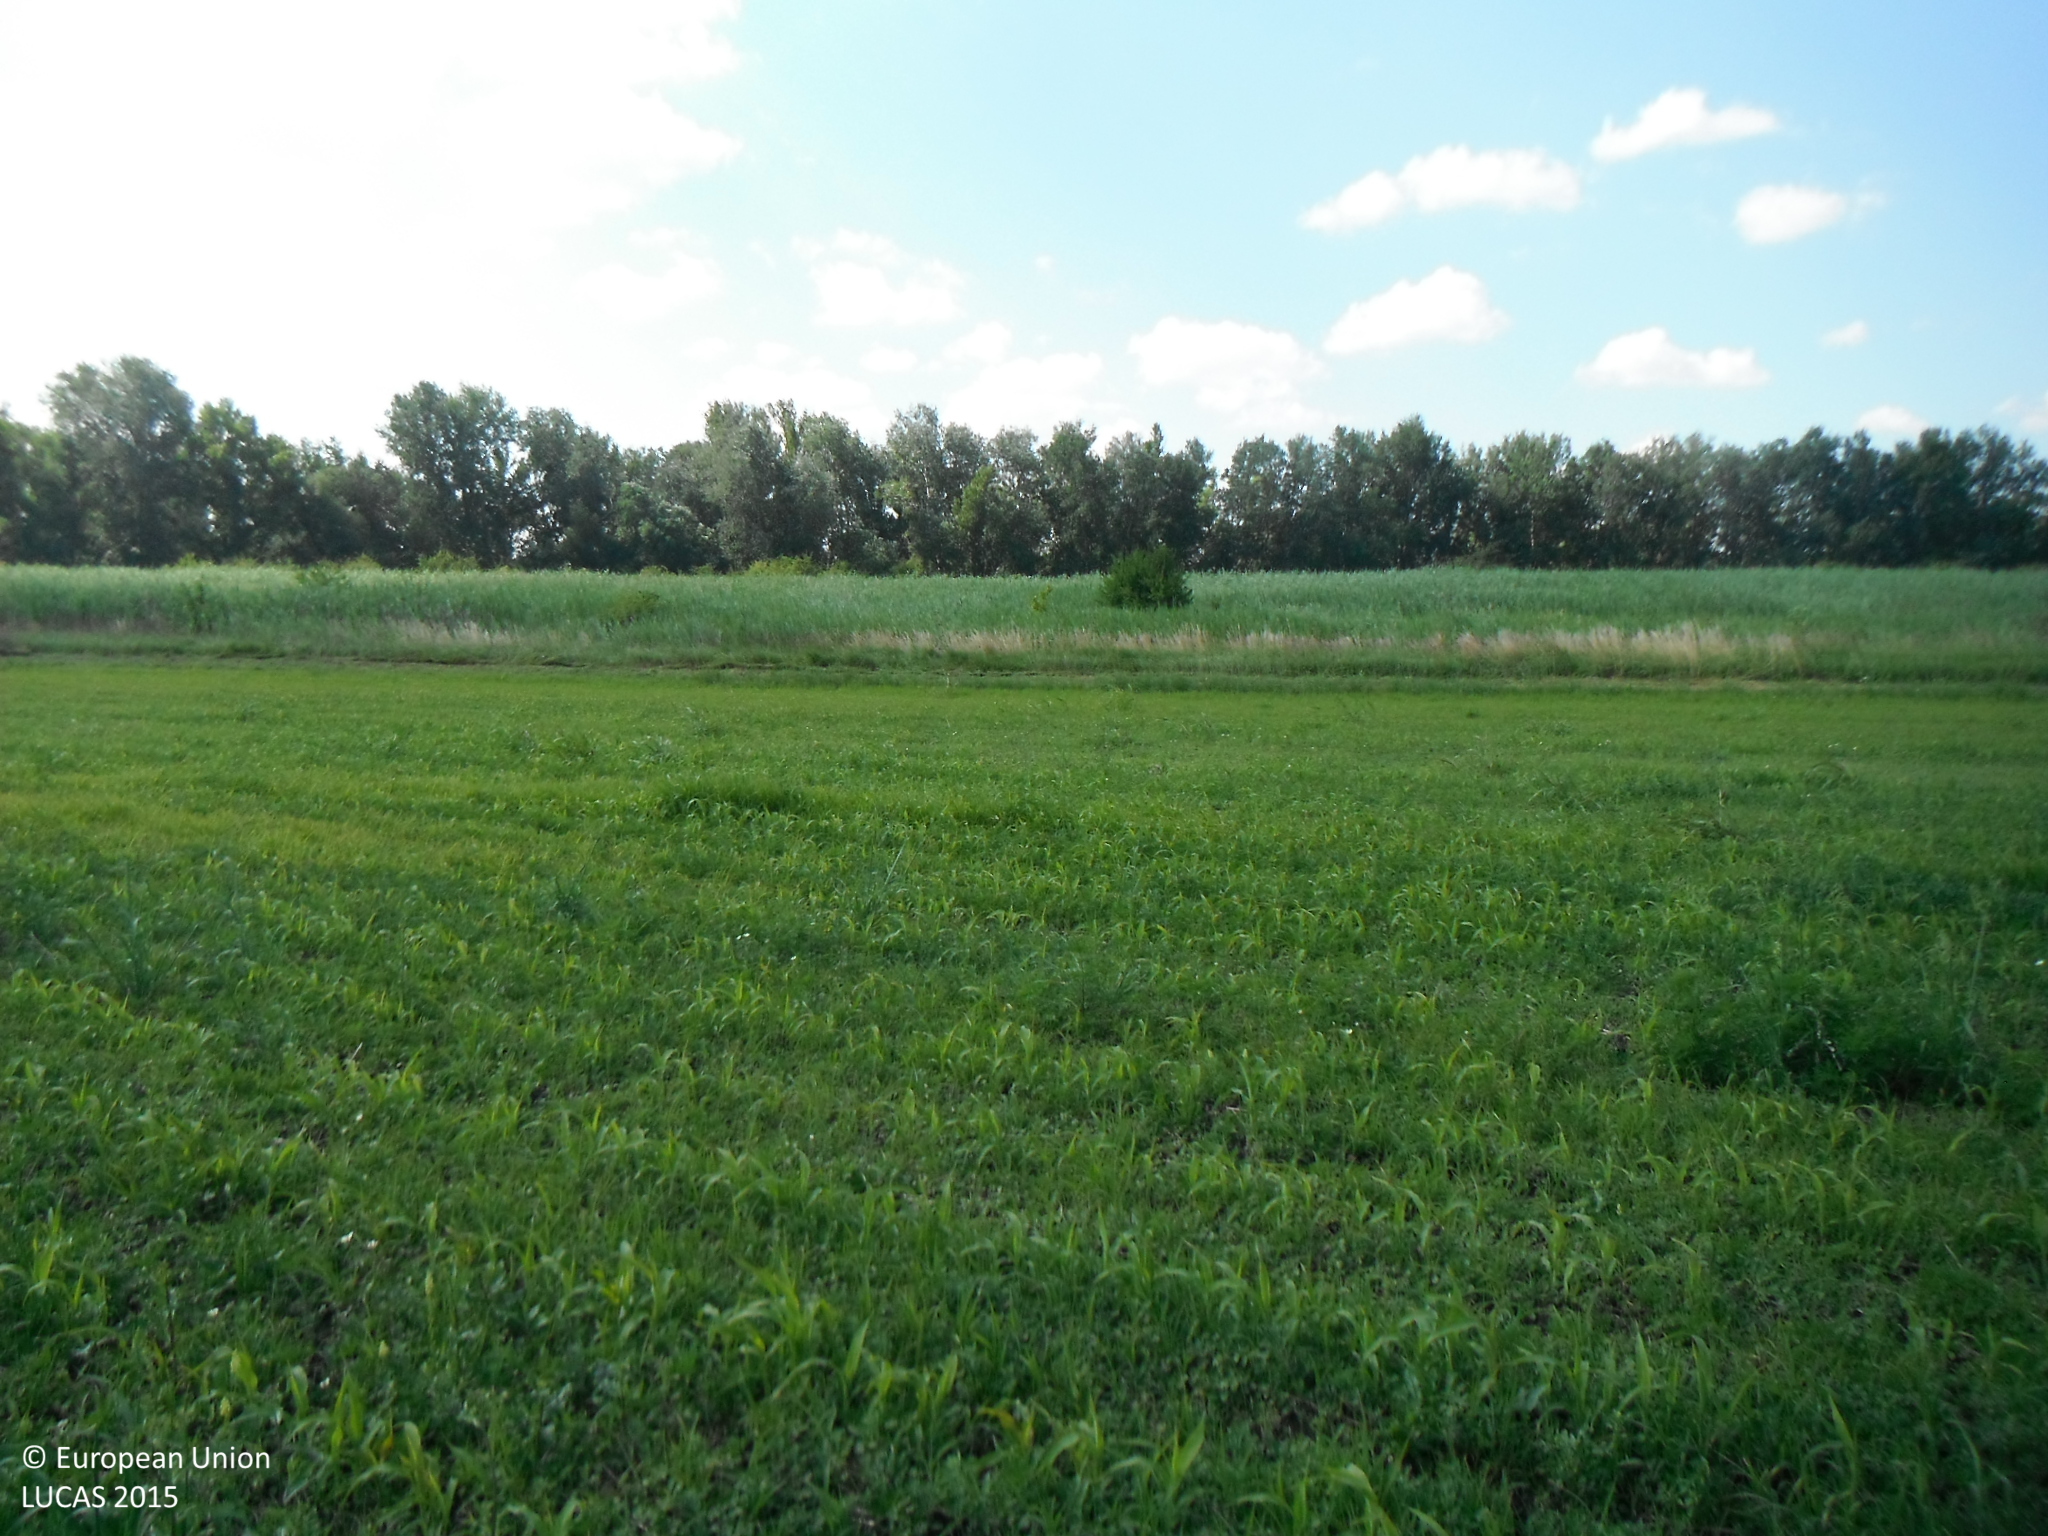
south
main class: Cropland
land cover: Maize
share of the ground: 10 - 25 %
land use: Agriculture (excluding fallow land and kitchen gardens)
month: June
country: SK
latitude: 47.7557
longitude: 18.1901
